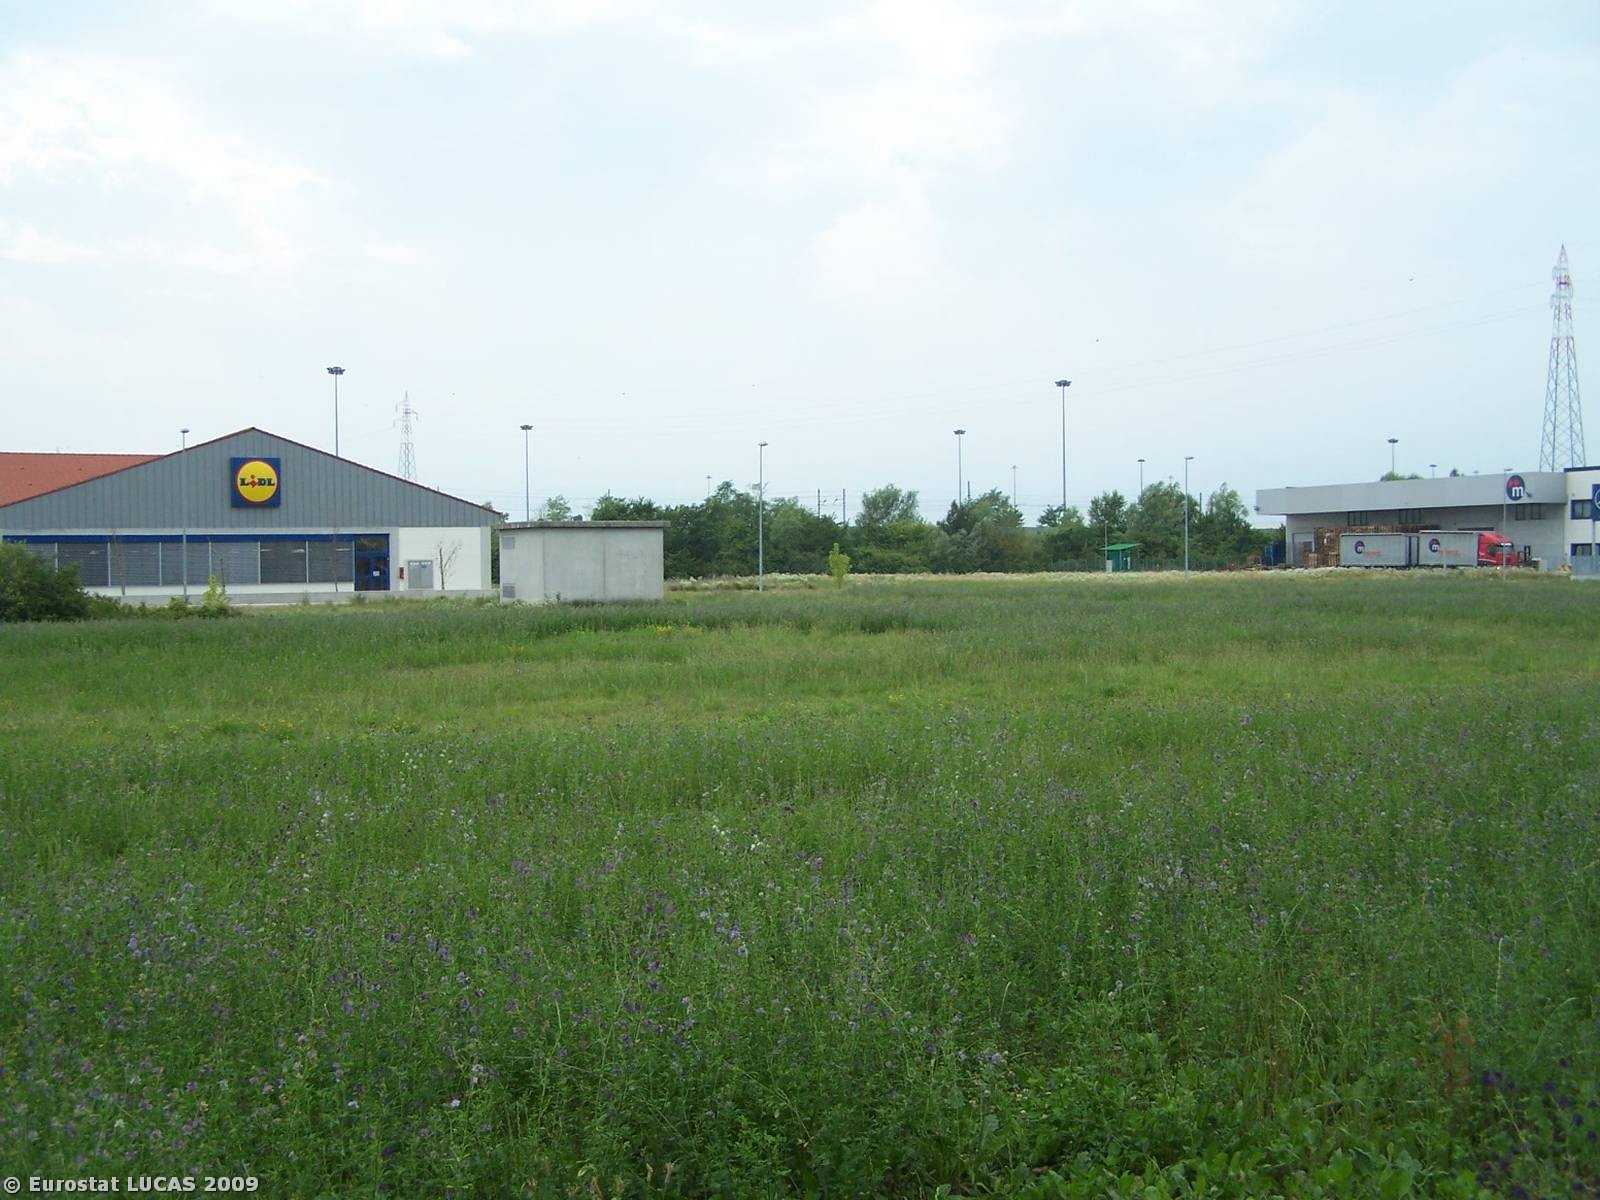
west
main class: Cropland
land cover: Lucerne
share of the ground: > 75 %
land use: Agriculture (excluding fallow land and kitchen gardens)
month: June
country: IT
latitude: 45.8306
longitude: 13.3302
